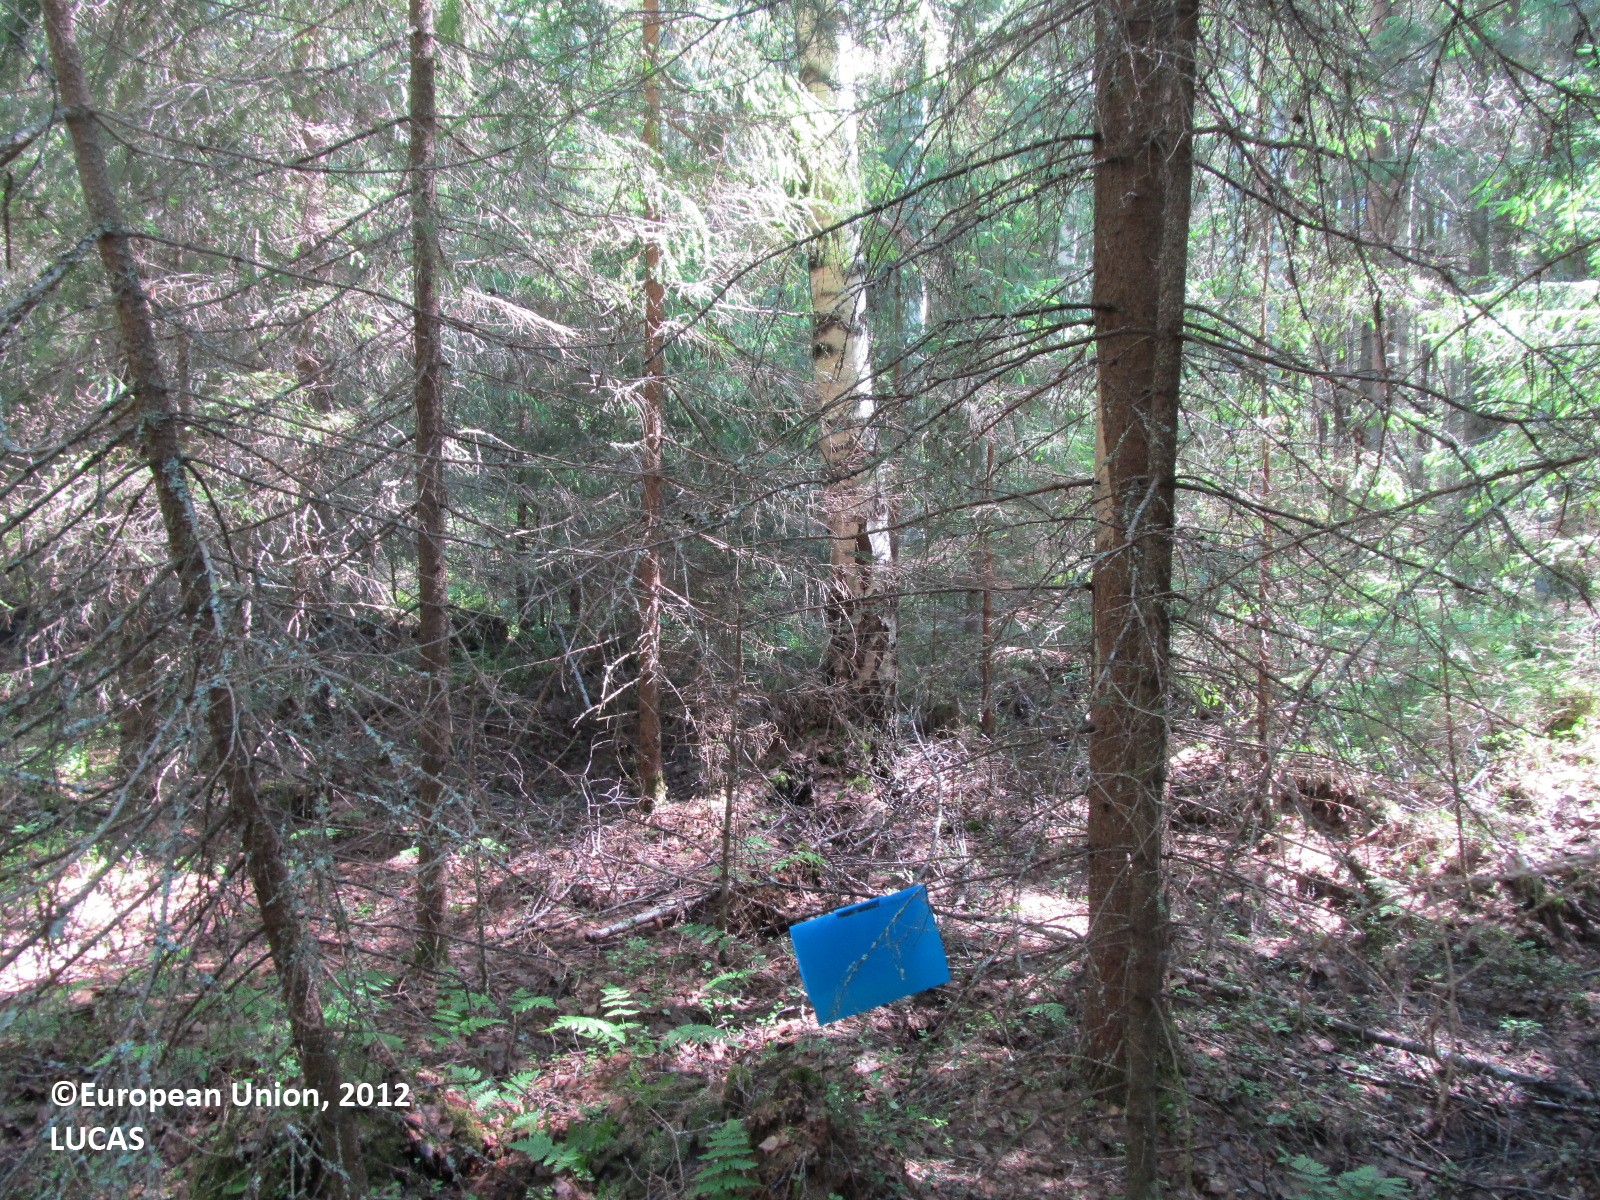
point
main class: Woodland
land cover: Spruce dominated mixed woodland
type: boreal forest
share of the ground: 50 - 75 %
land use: Forestry
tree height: > 5 m
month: July
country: FI
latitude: 62.4672
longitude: 29.1317
